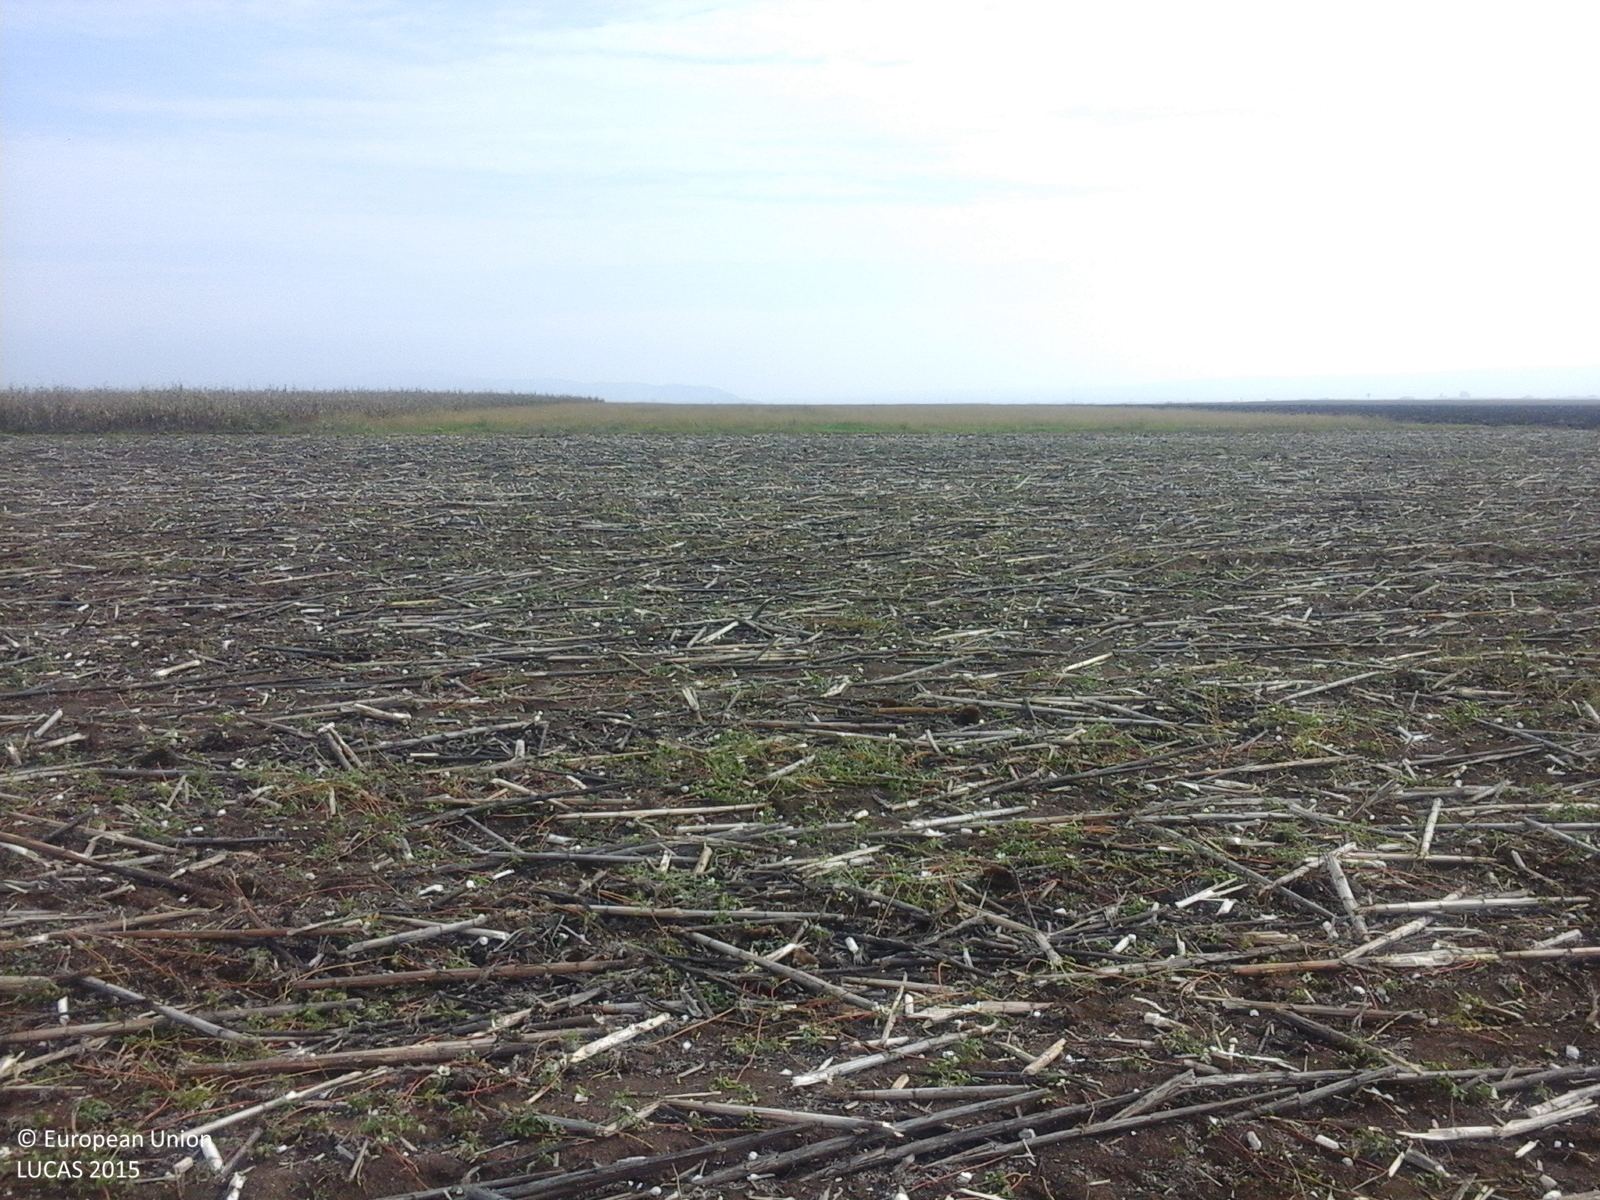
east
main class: Cropland
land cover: Sunflower
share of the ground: 10 - 25 %
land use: Agriculture (excluding fallow land and kitchen gardens)
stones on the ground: < 10 %
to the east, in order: Sunflower; Grass margins; Tracks; Grass margins; Common wheat; Other bare soil; Common wheat
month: October
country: RO
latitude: 46.1711
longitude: 23.6027
